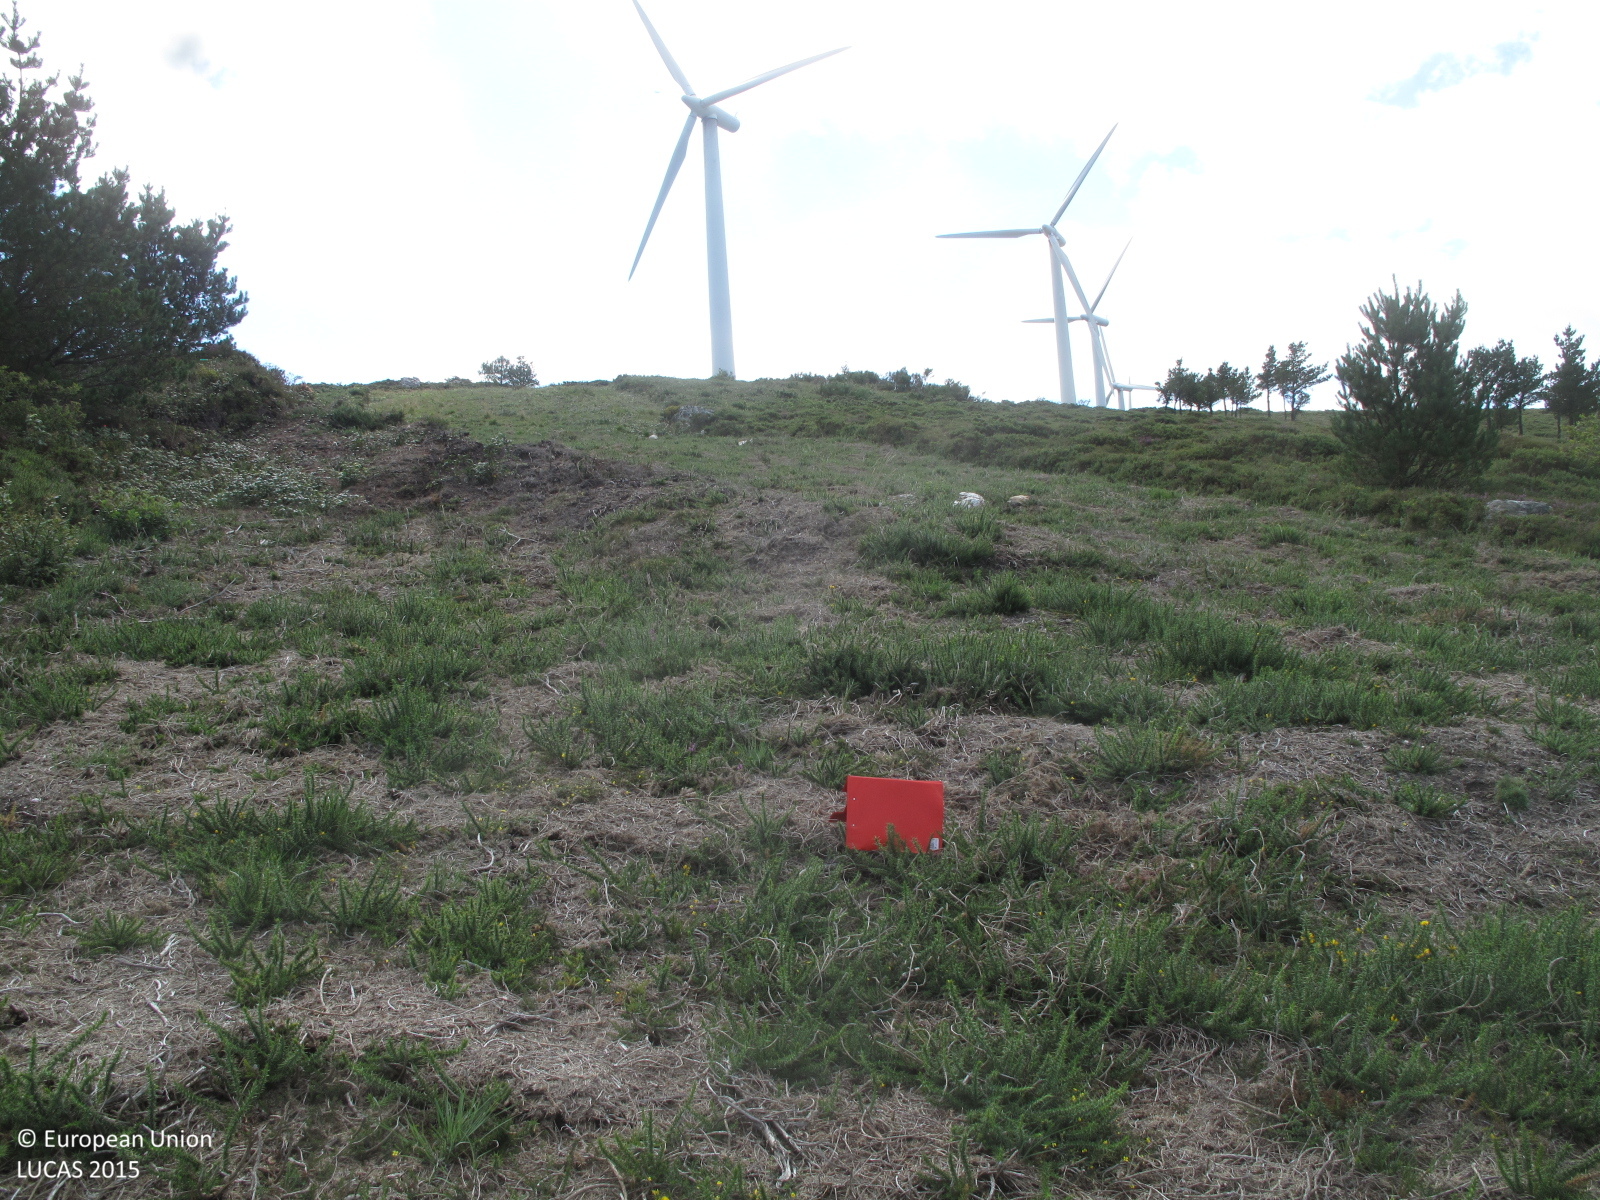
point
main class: Shrubland
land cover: Shrubland with sparse tree cover
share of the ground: > 75 %
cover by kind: shrubs 85 %, herbaceous plants 10 %, coniferous forest trees 5 %
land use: Abandoned areas
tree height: < 5 m
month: July
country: ES
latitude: 42.8604
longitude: -9.0549
